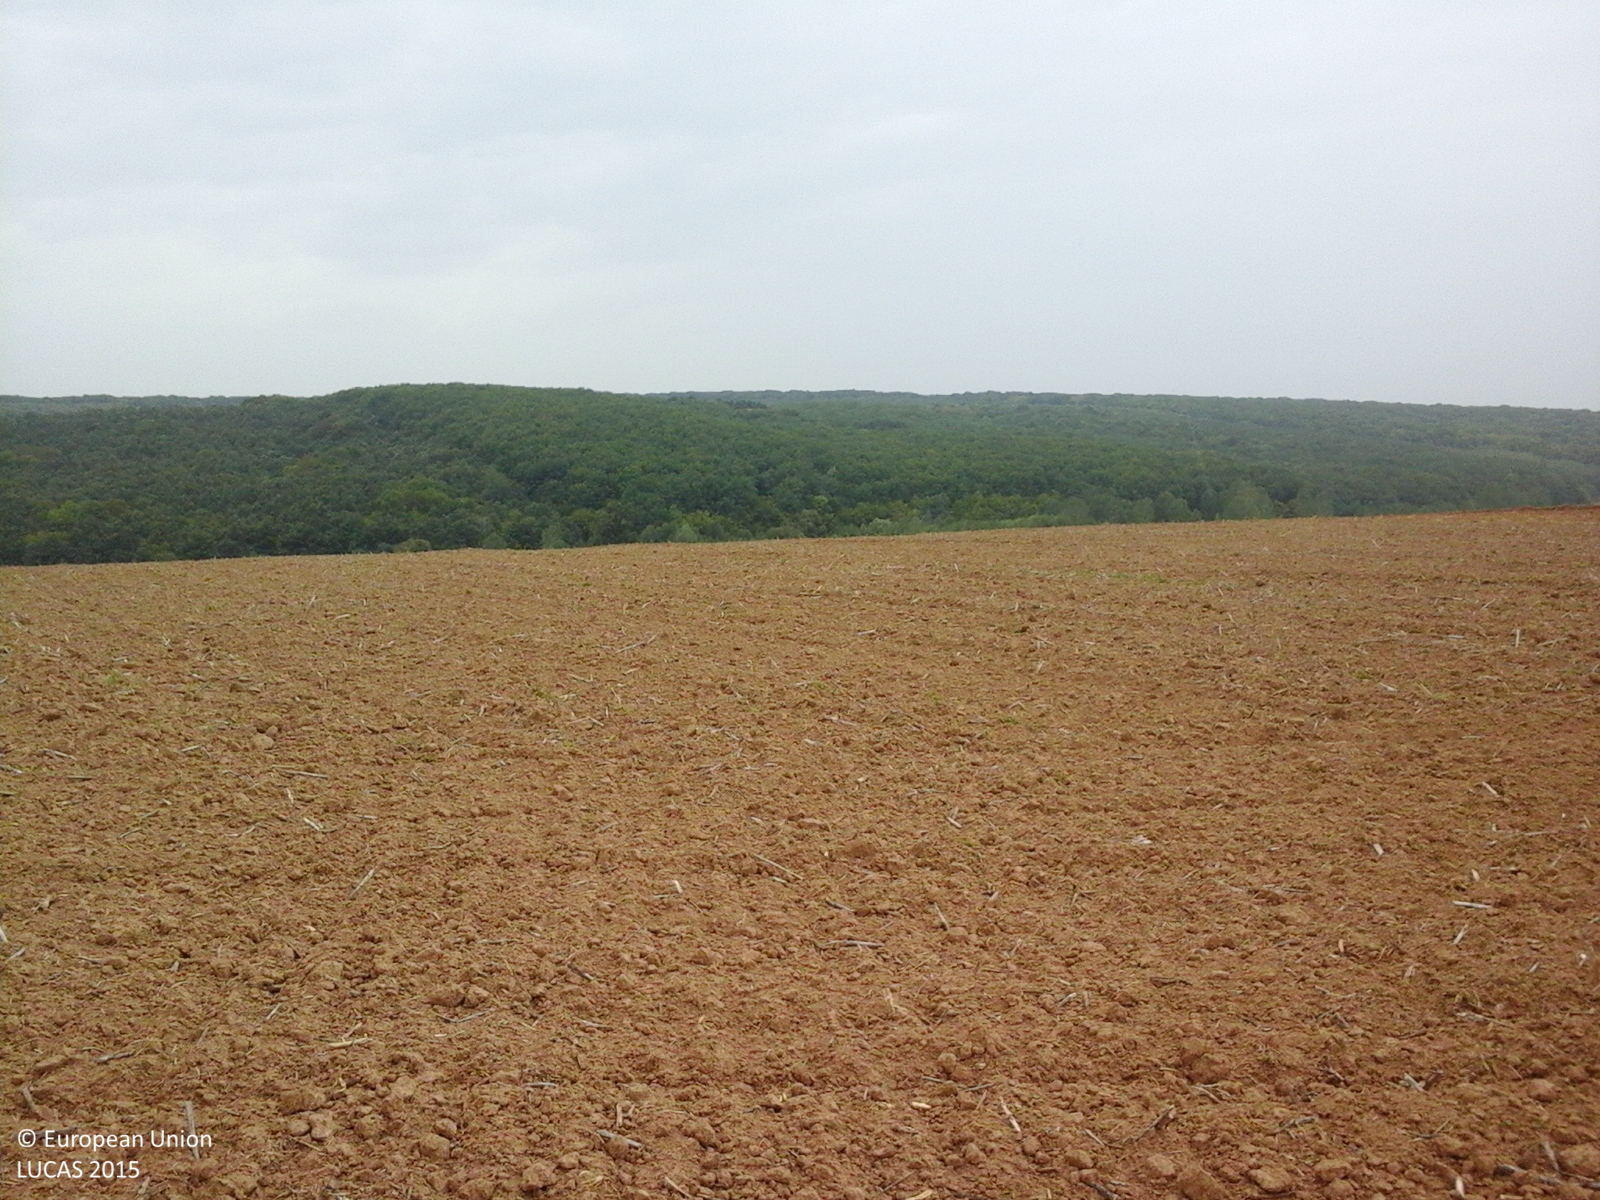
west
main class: Cropland
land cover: Rape and turnip rape
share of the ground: < 10 %
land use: Agriculture (excluding fallow land and kitchen gardens)
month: September
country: RO
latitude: 47.3764
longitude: 22.3850
